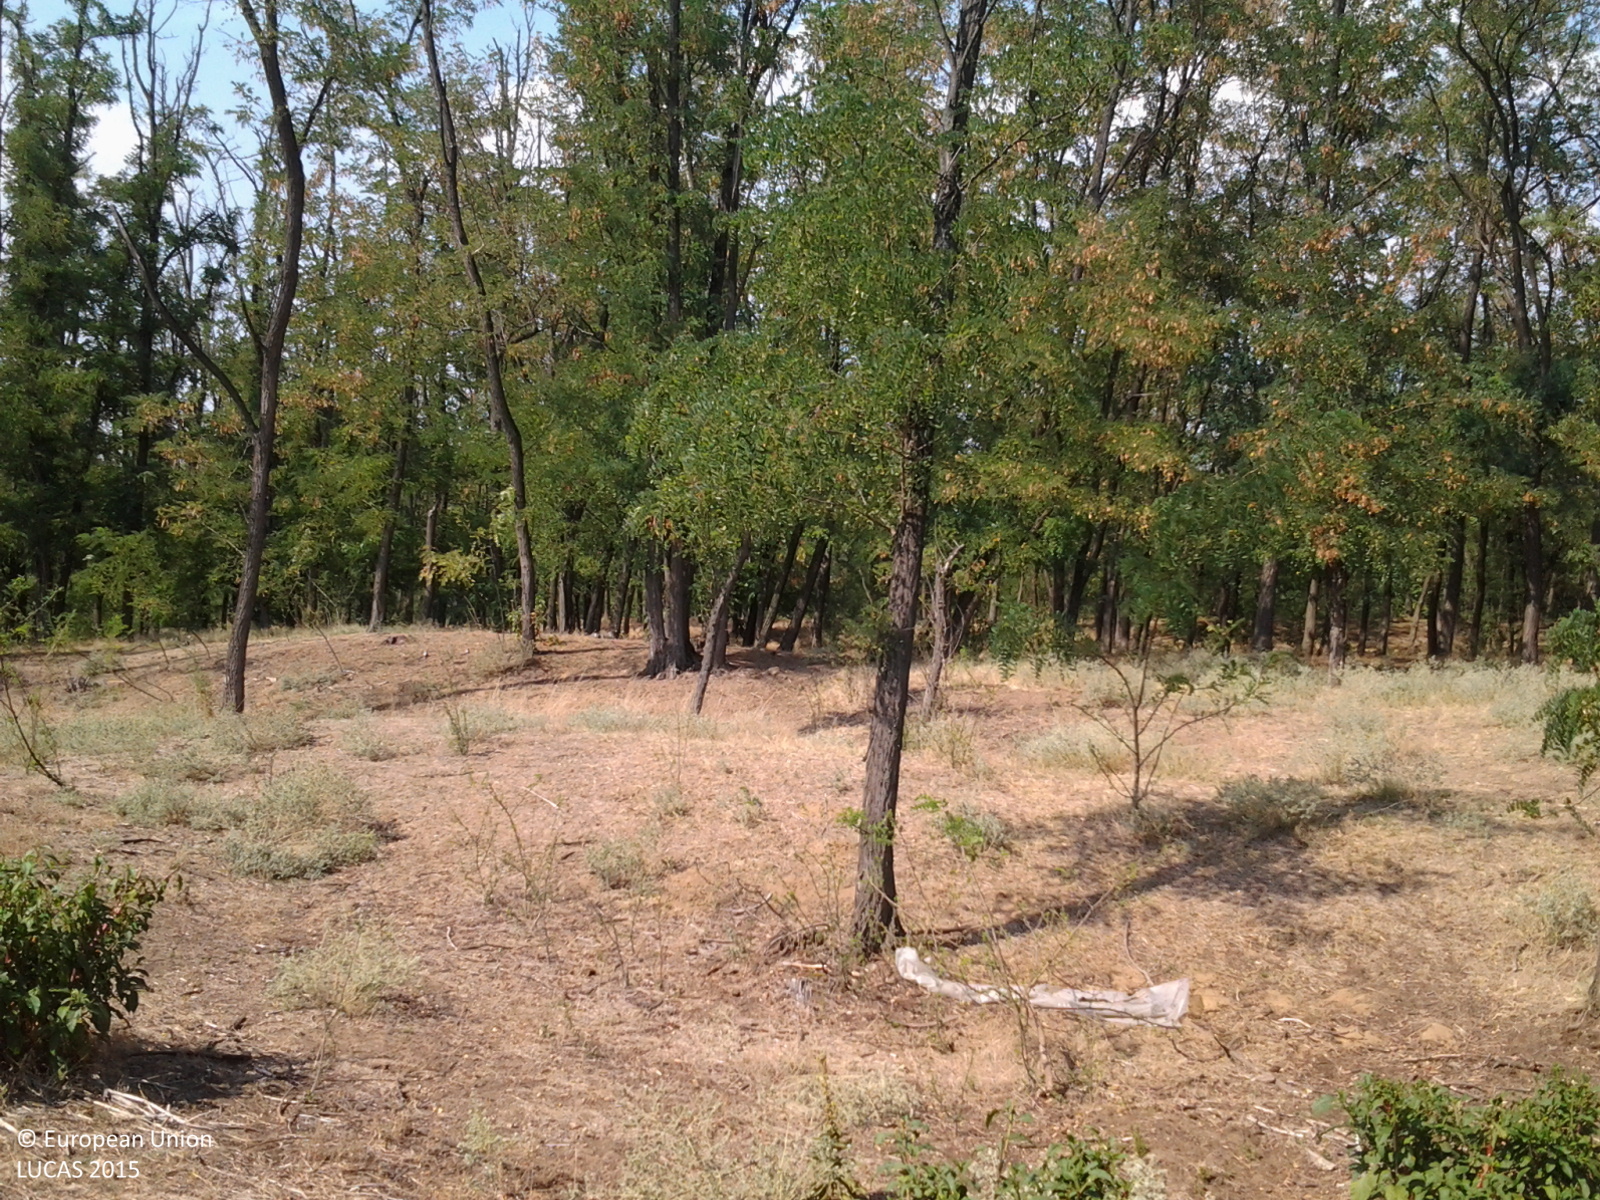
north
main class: Woodland
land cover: Broadleaved woodland
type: exotic forest
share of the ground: > 75 %
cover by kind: broadleaved forest trees 100 %
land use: Forestry
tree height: > 5 m
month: August
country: RO
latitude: 43.8668
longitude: 23.0692
